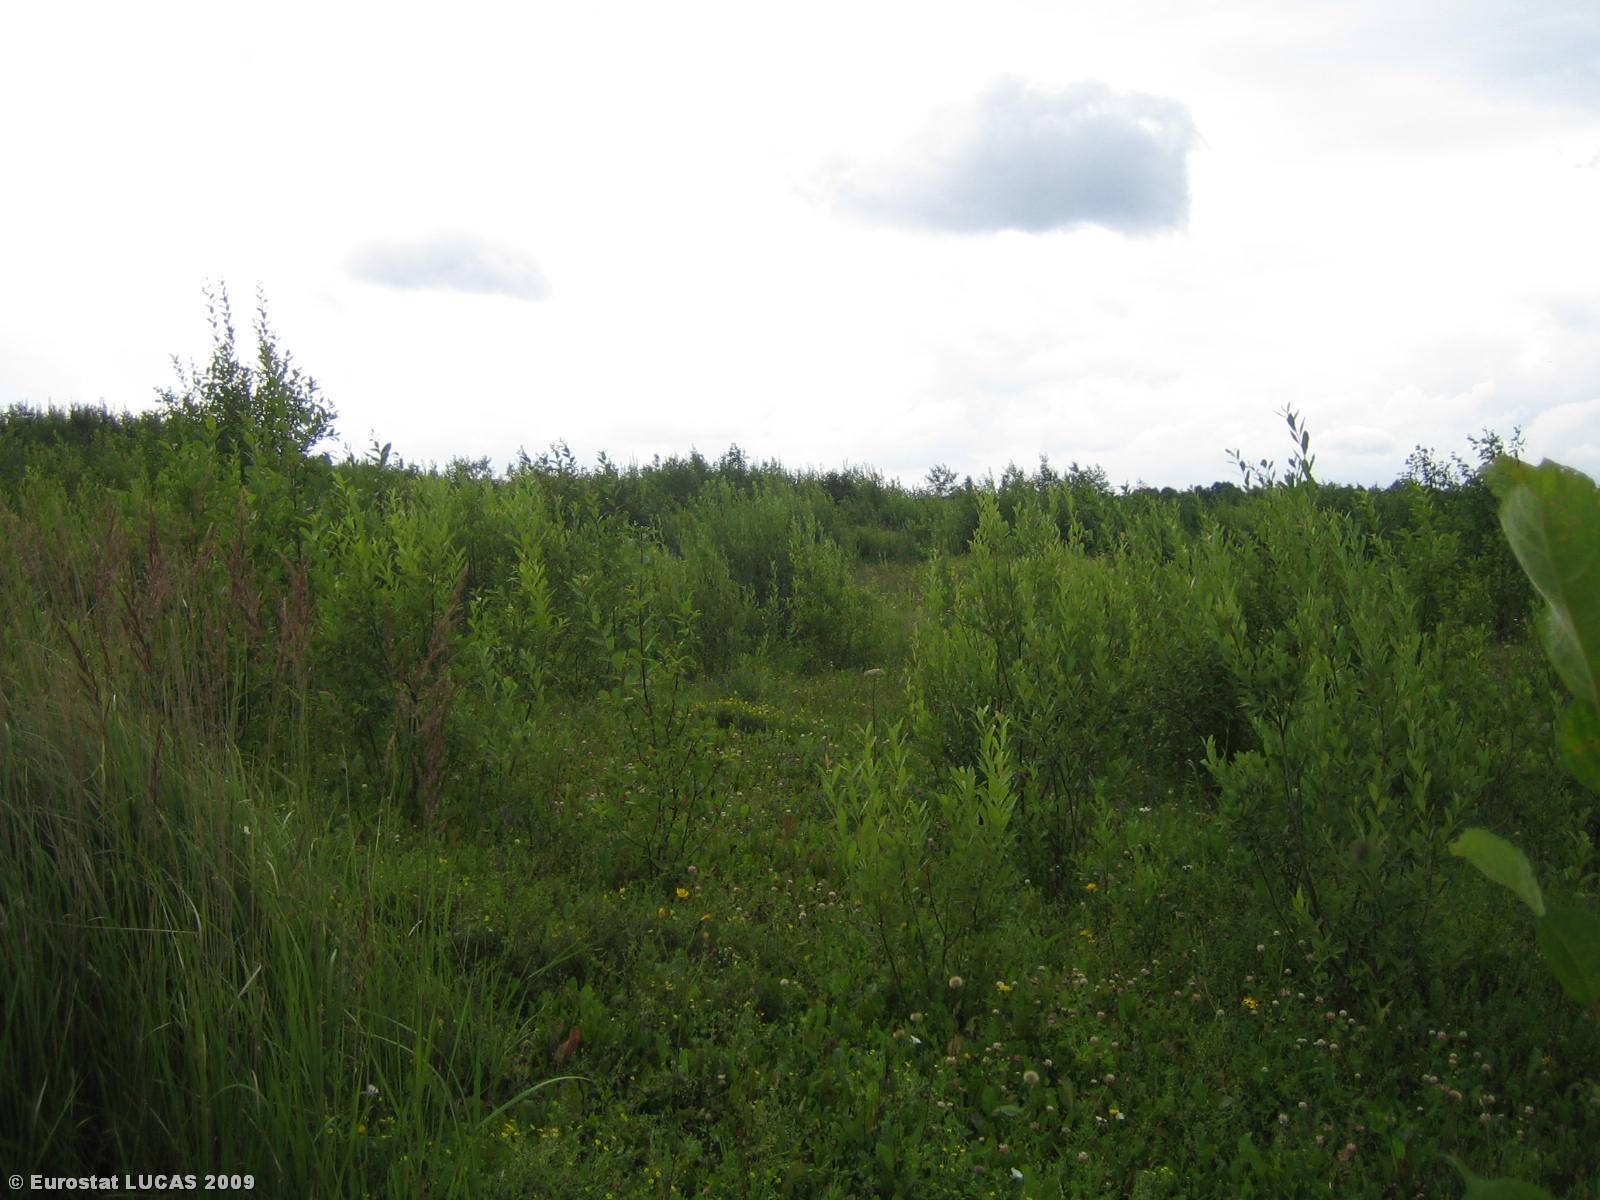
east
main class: Grassland
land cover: Grassland with sparse tree/shrub cover
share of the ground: > 75 %
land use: Agriculture (excluding fallow land and kitchen gardens)
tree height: < 5 m
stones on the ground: < 10 %
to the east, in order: Grassland with sparse tree/shrub cover
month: July
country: LT
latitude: 55.4097
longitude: 25.5899
